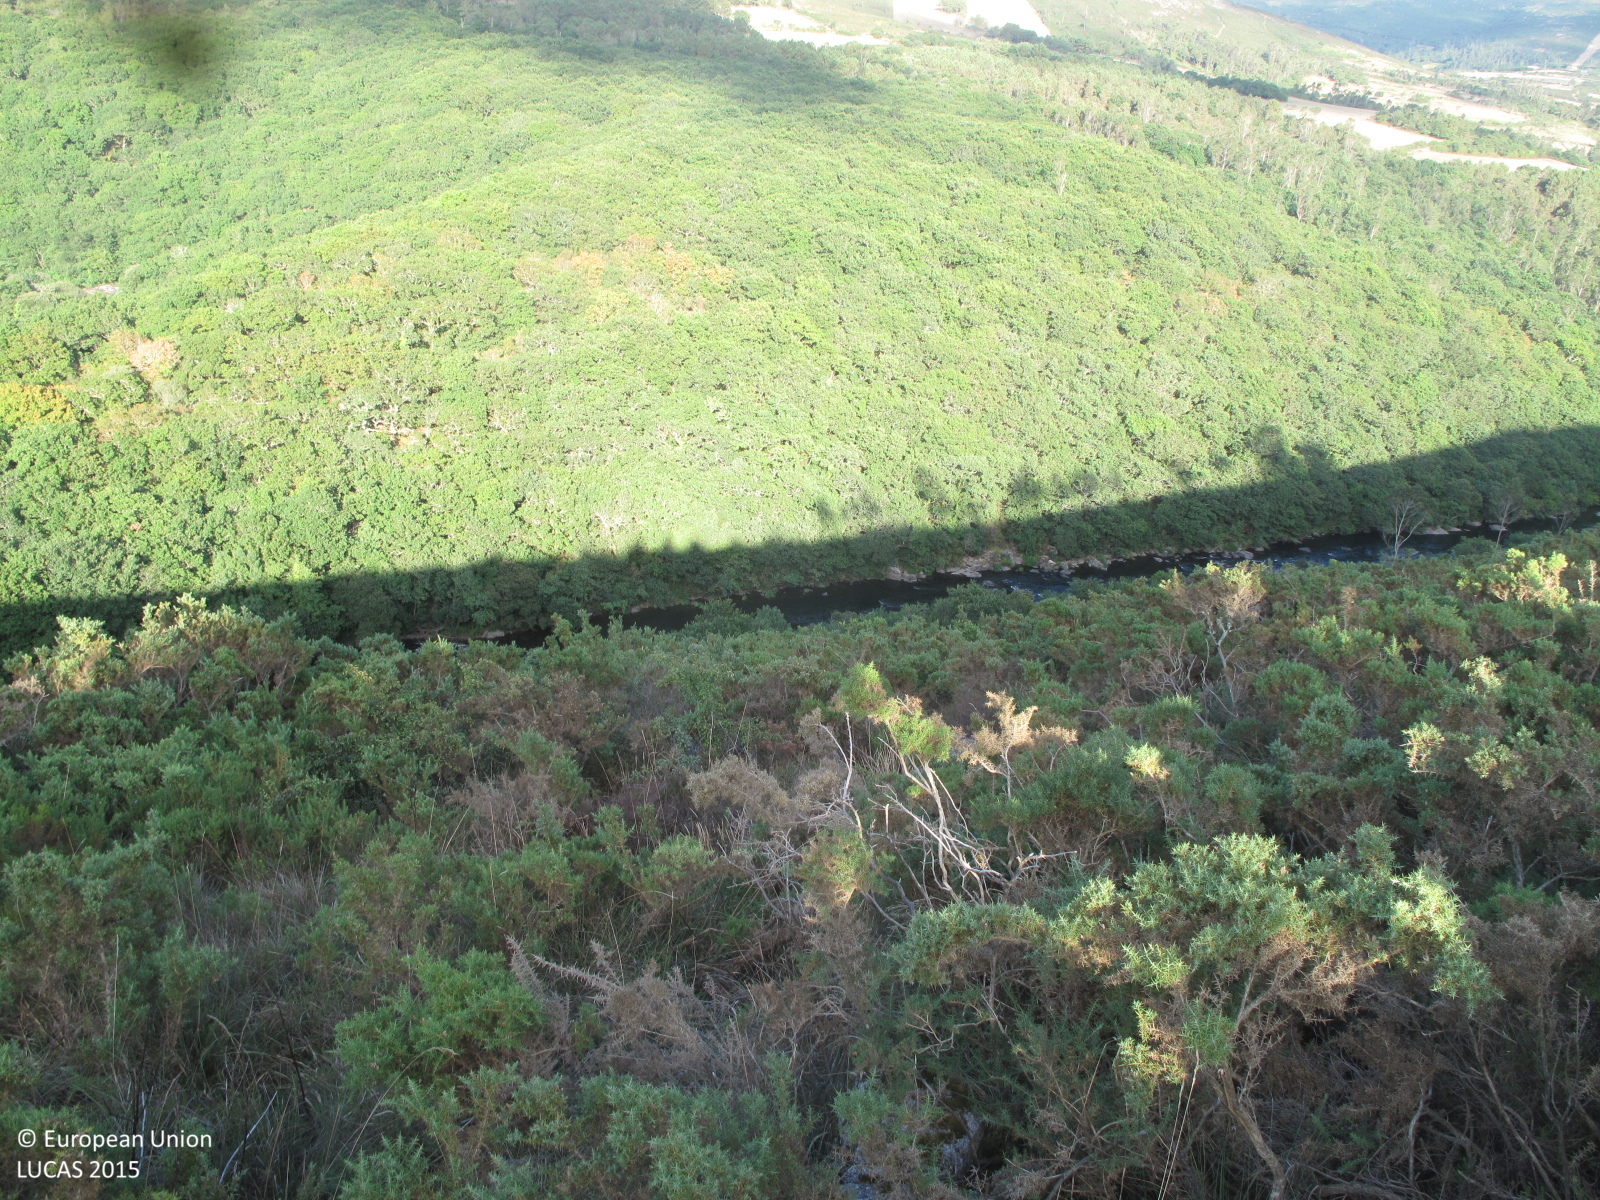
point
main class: Shrubland
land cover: Shrubland without tree cover
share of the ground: > 75 %
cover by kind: shrubs 90 %, herbaceous plants 10 %
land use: Semi-natural and natural areas not in use
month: July
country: ES
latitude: 42.9474
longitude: -9.0837
